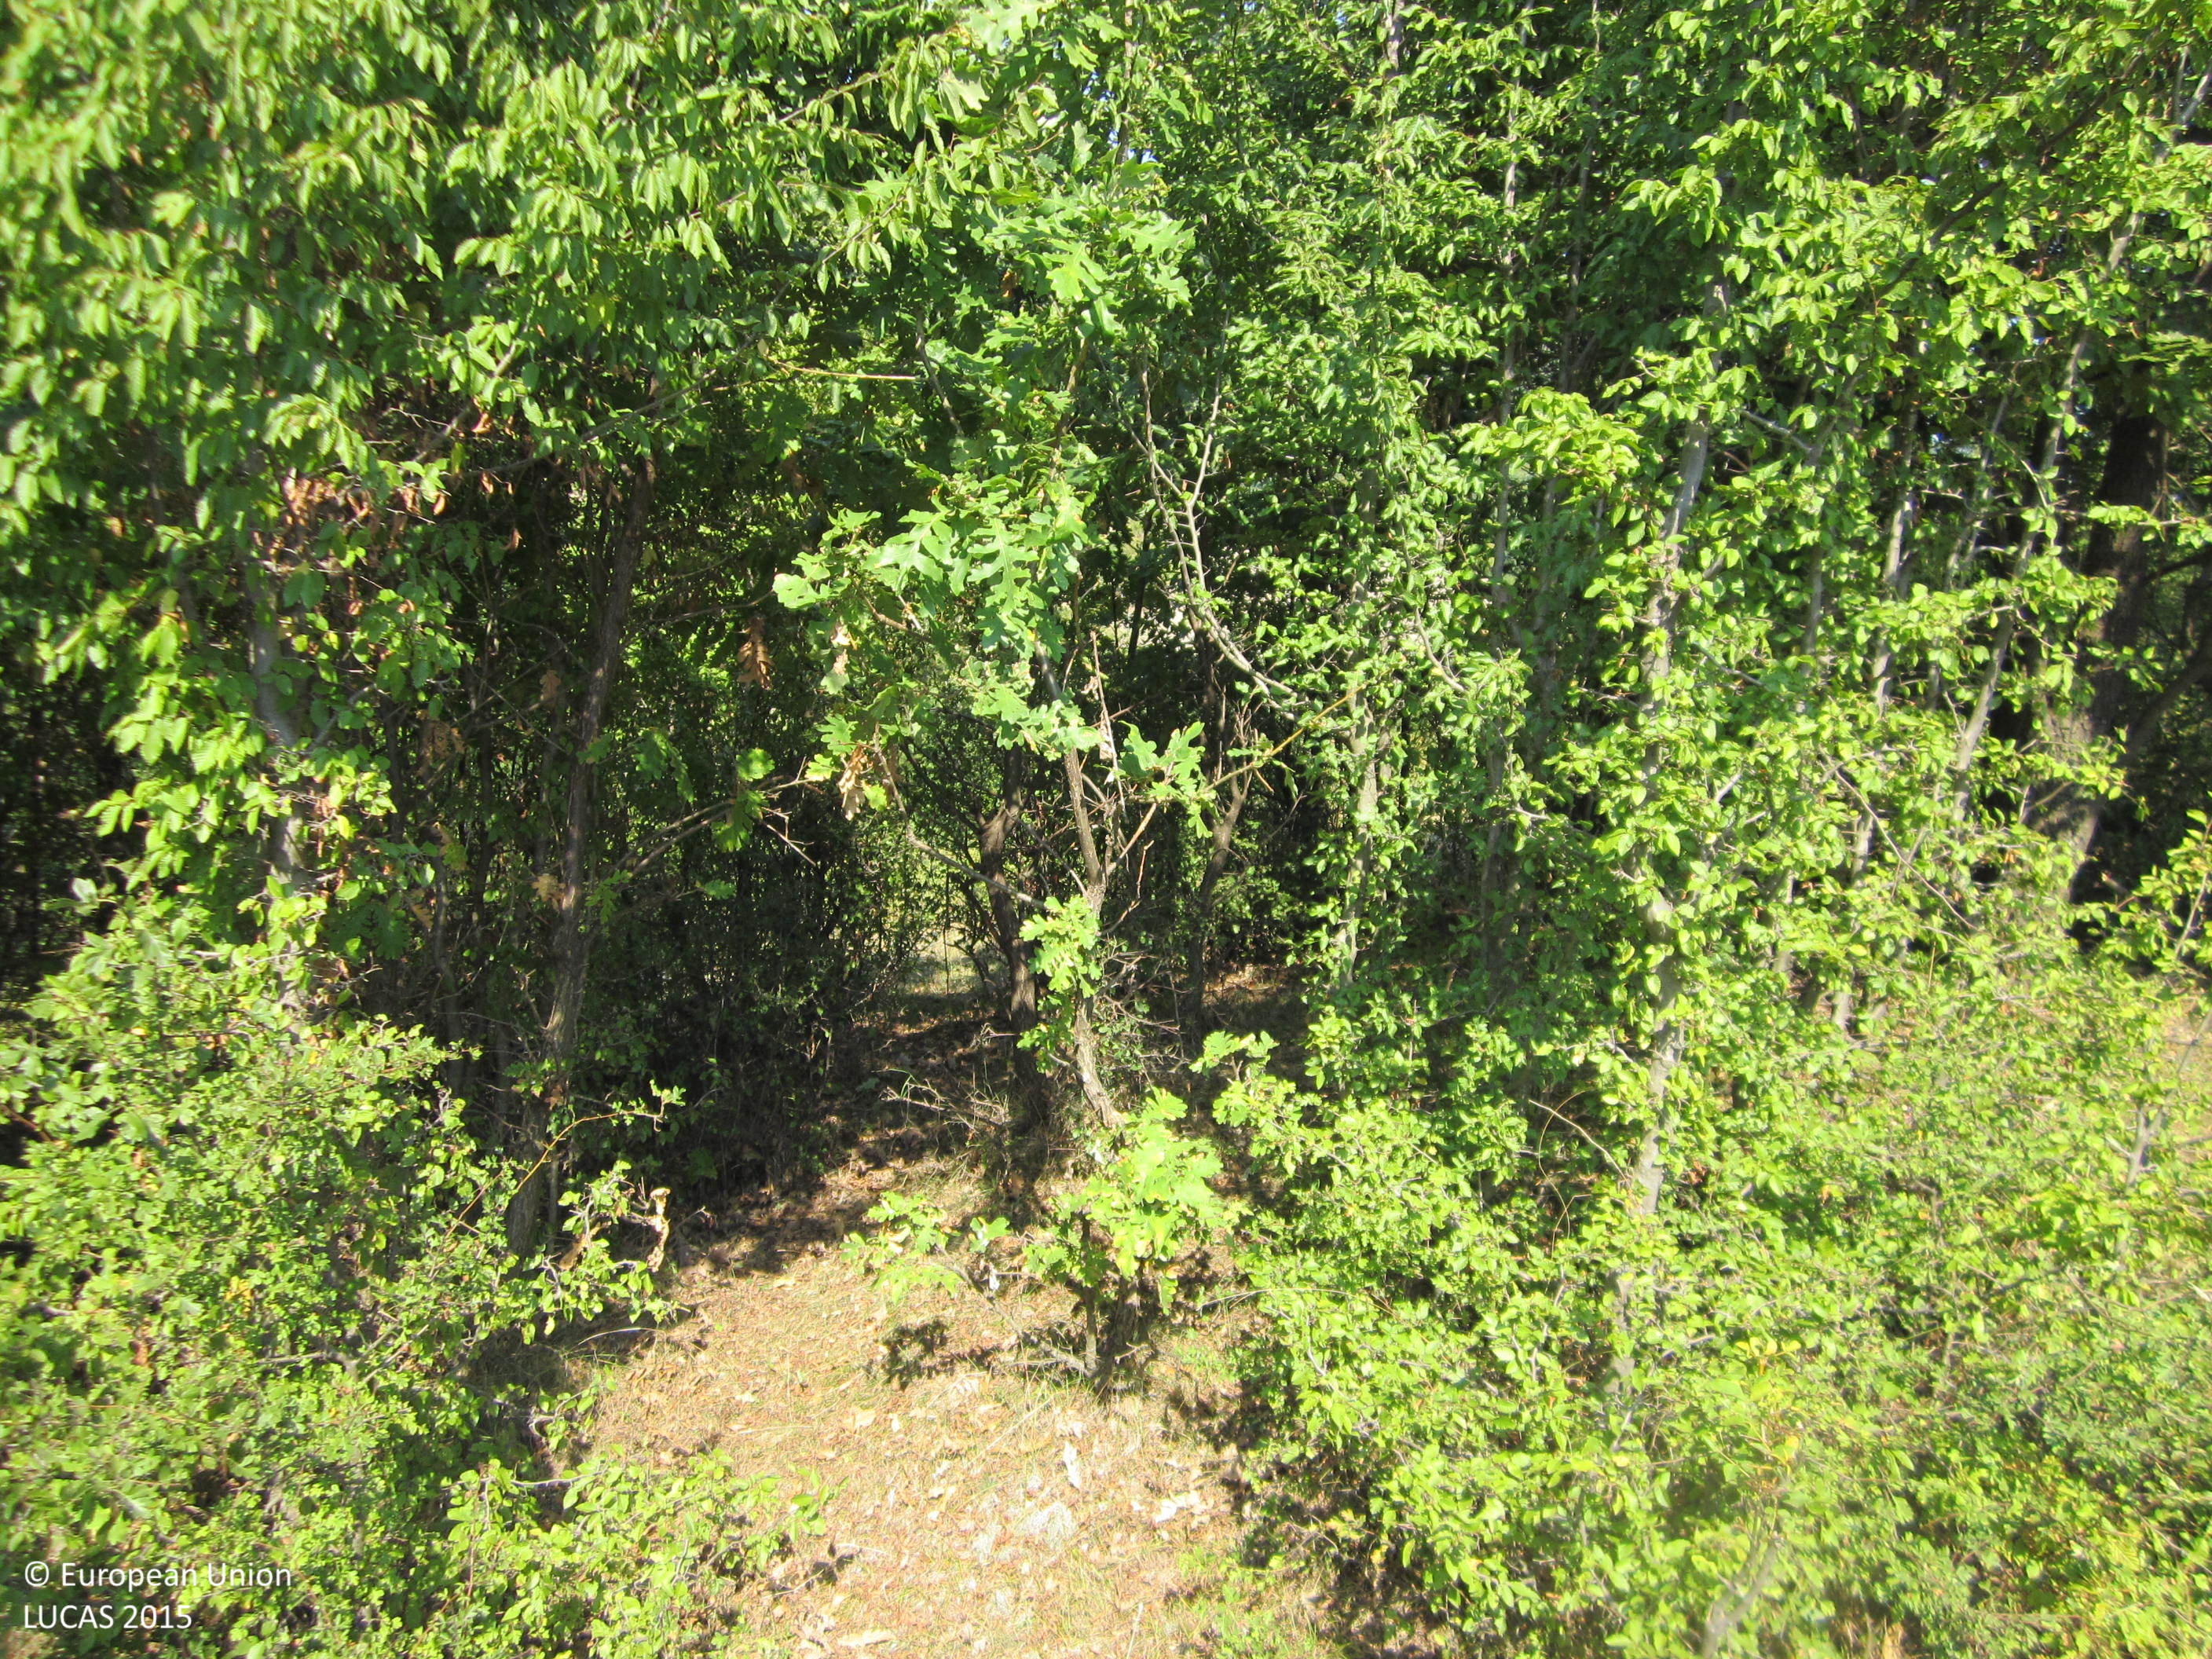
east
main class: Woodland
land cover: Broadleaved woodland
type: mesophytic deciduous forest
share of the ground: > 75 %
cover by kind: broadleaved forest trees 85 %, herbaceous plants 15 %
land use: Forestry
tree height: > 5 m
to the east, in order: Broadleaved woodland
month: September
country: BG
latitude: 42.9310
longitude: 27.1332
